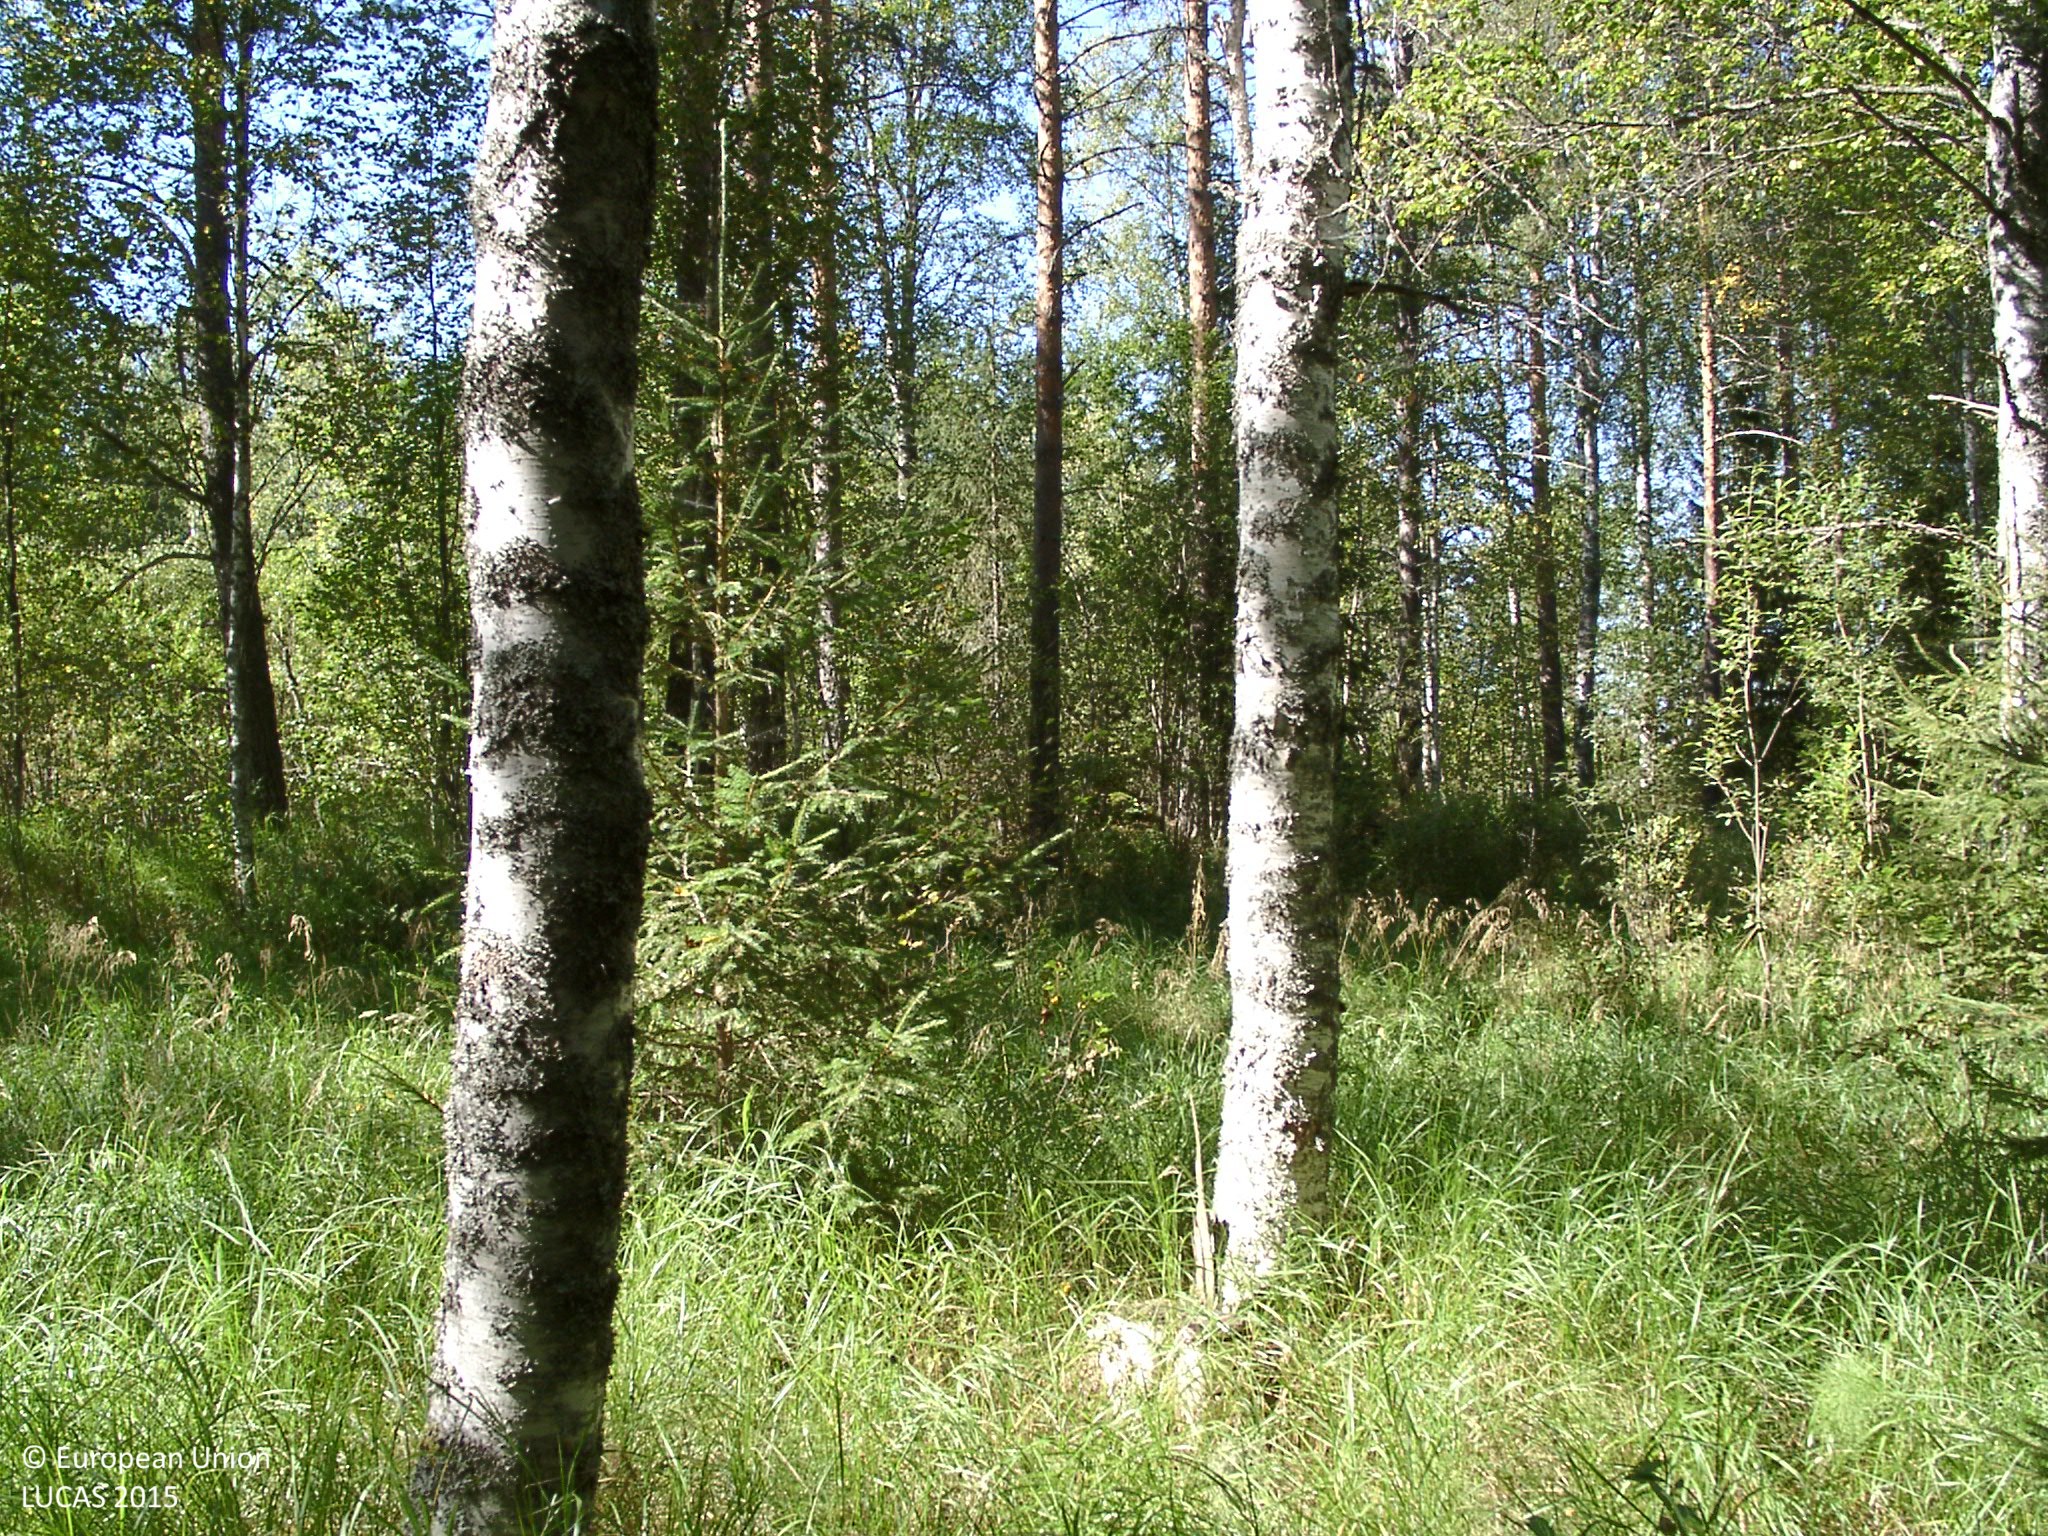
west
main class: Woodland
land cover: Other mixed woodland
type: boreal forest
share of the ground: 50 - 75 %
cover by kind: herbaceous plants 40 %, coniferous forest trees 30 %, broadleaved forest trees 30 %
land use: Forestry
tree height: > 5 m
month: August
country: FI
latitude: 61.9689
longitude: 24.9633
